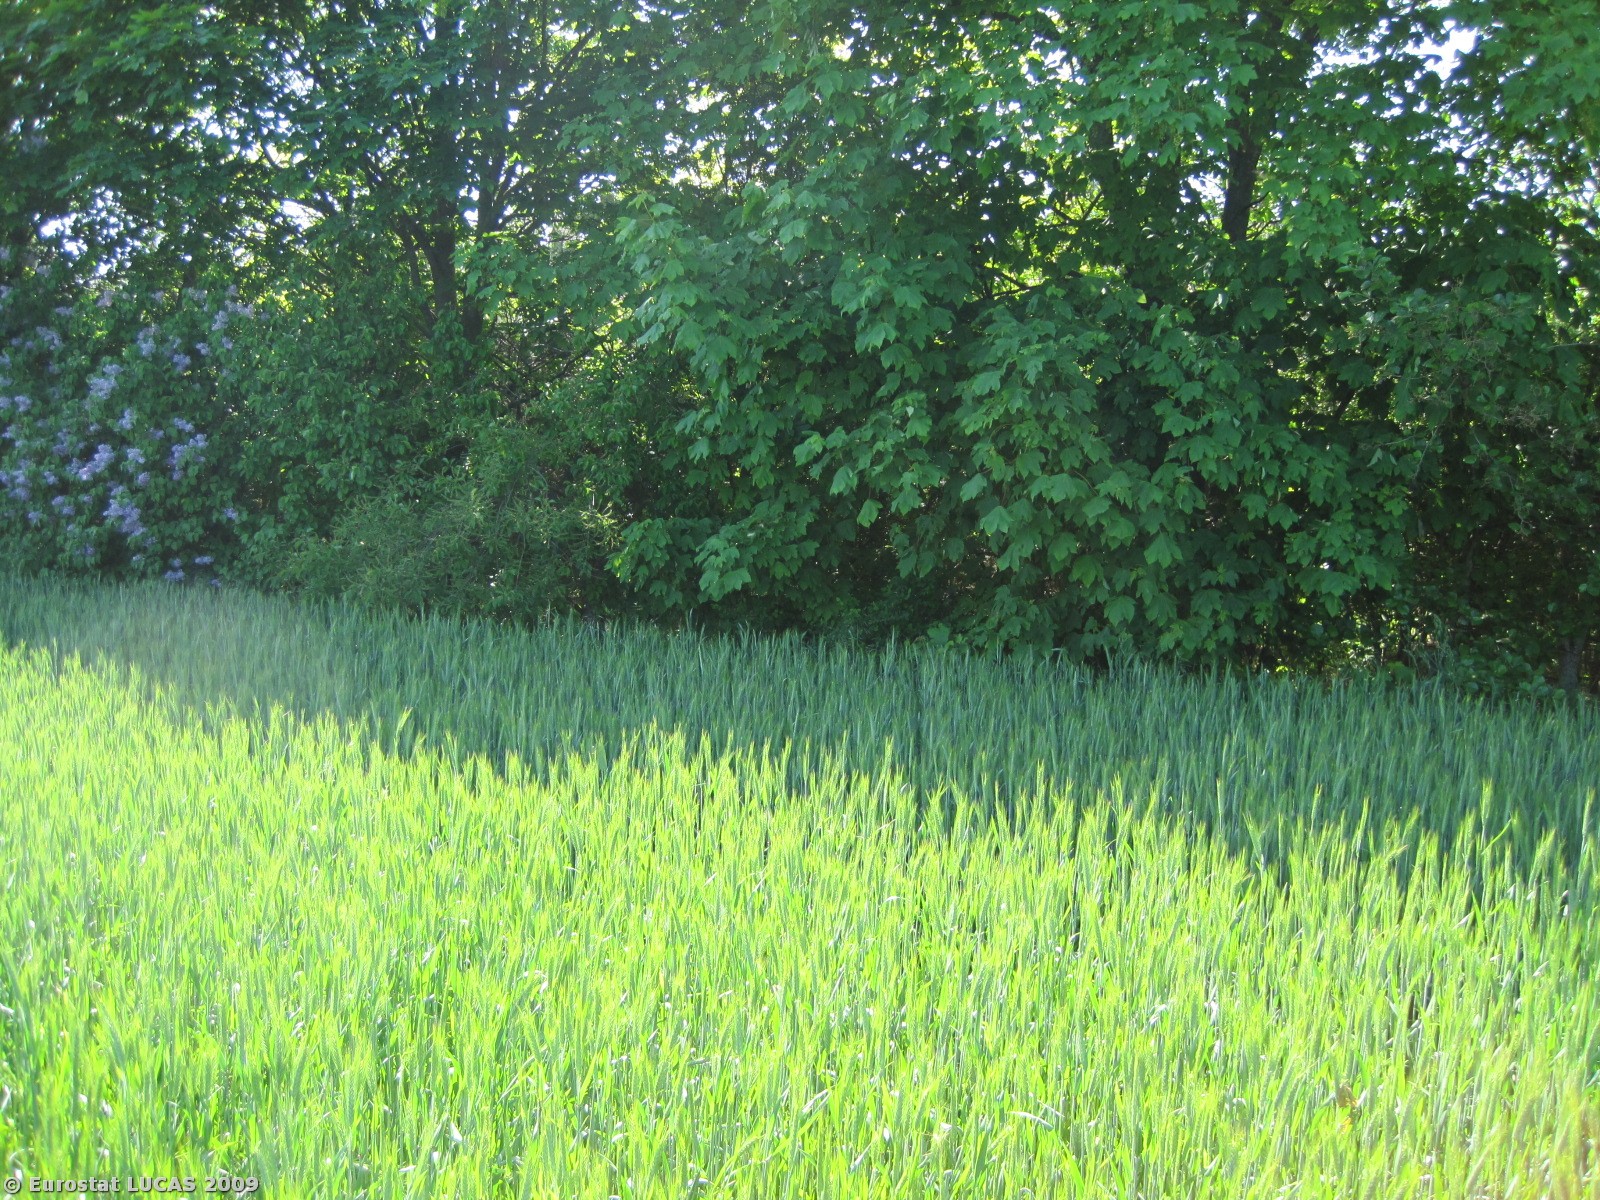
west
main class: Cropland
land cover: Barley
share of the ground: > 75 %
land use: Agriculture (excluding fallow land and kitchen gardens)
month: May
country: DK
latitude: 56.4572
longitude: 10.2107
